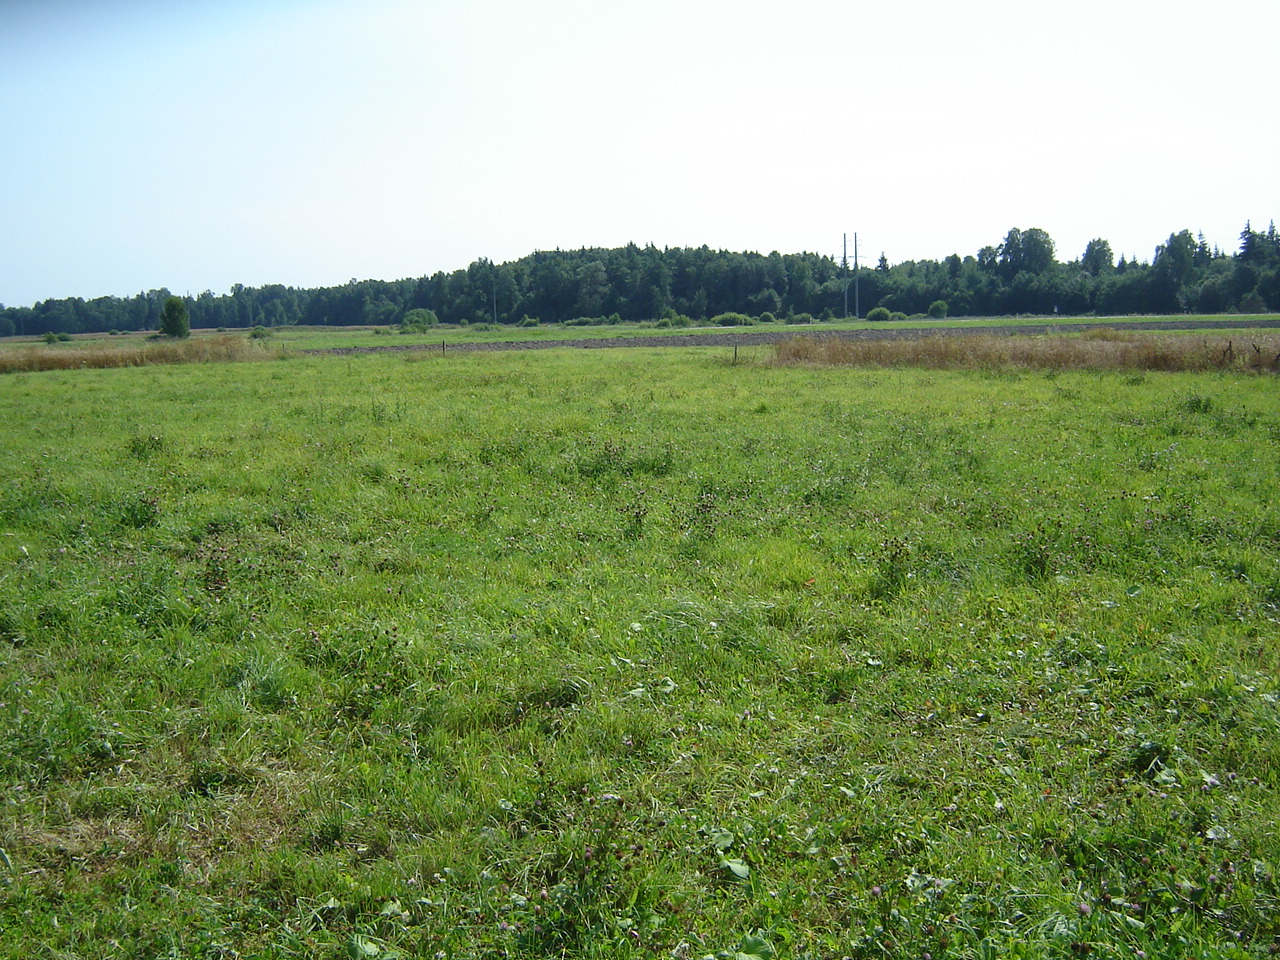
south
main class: Grassland
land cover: Grassland without tree/shrub cover
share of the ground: > 75 %
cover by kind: herbaceous plants 100 %
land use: Agriculture (excluding fallow land and kitchen gardens)
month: August
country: LT
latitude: 55.0289
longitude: 24.9588
